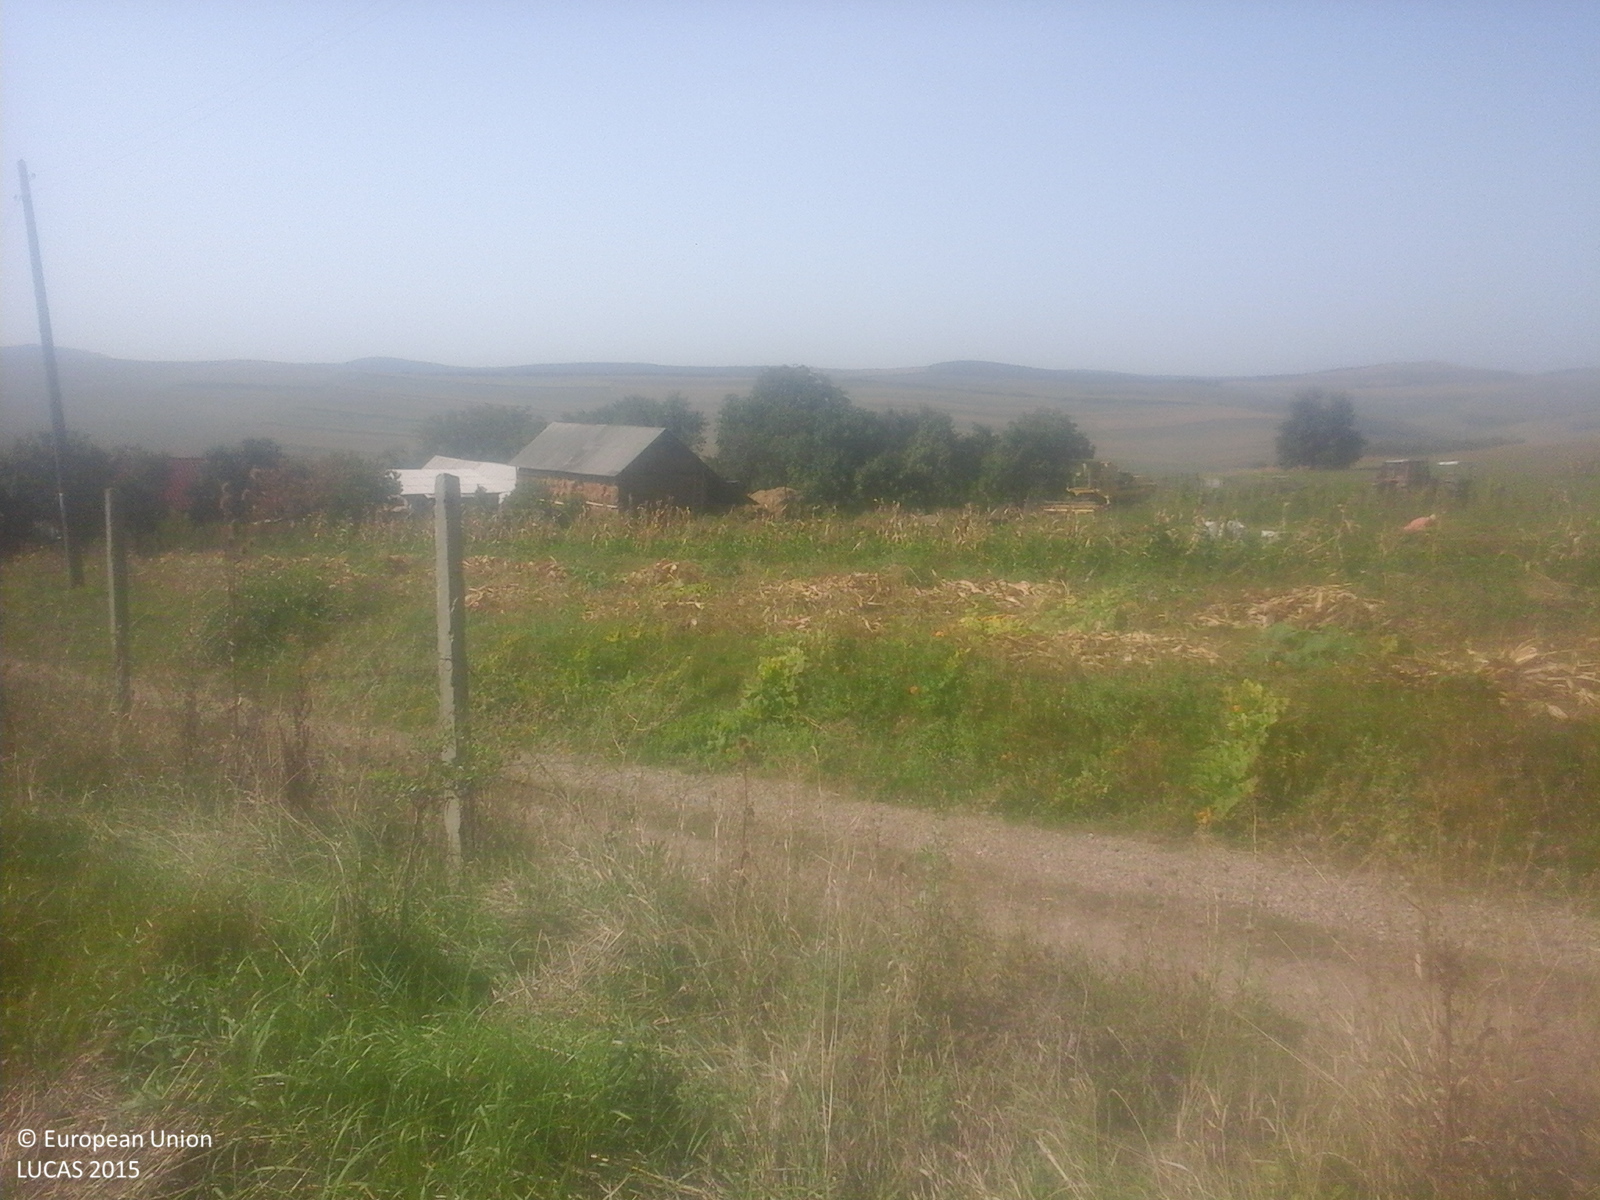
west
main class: Cropland
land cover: Common wheat
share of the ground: 50 - 75 %
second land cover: Spontaneously vegetated surfaces
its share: 25 - 50 %
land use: Agriculture (excluding fallow land and kitchen gardens)
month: September
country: RO
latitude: 46.9257
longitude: 24.2552
